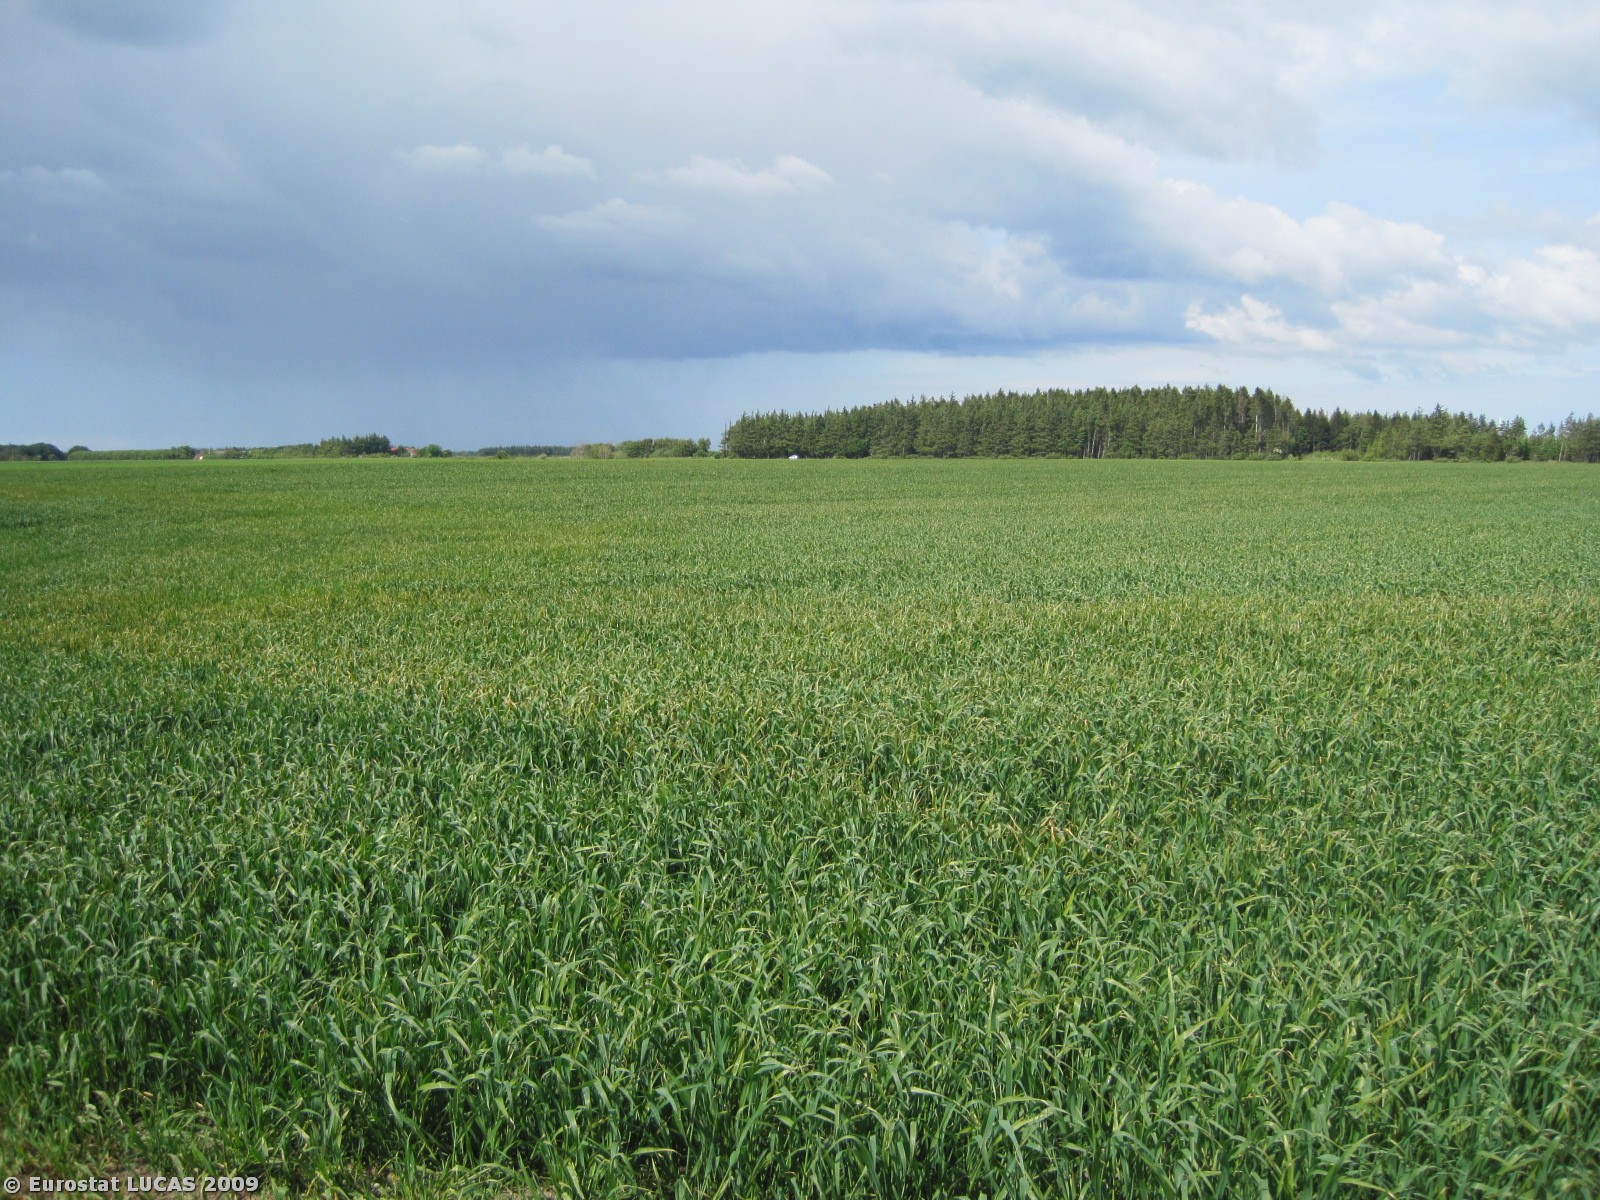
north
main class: Cropland
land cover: Rye
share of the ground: > 75 %
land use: Agriculture (excluding fallow land and kitchen gardens)
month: June
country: DK
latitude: 57.3382
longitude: 9.8507
